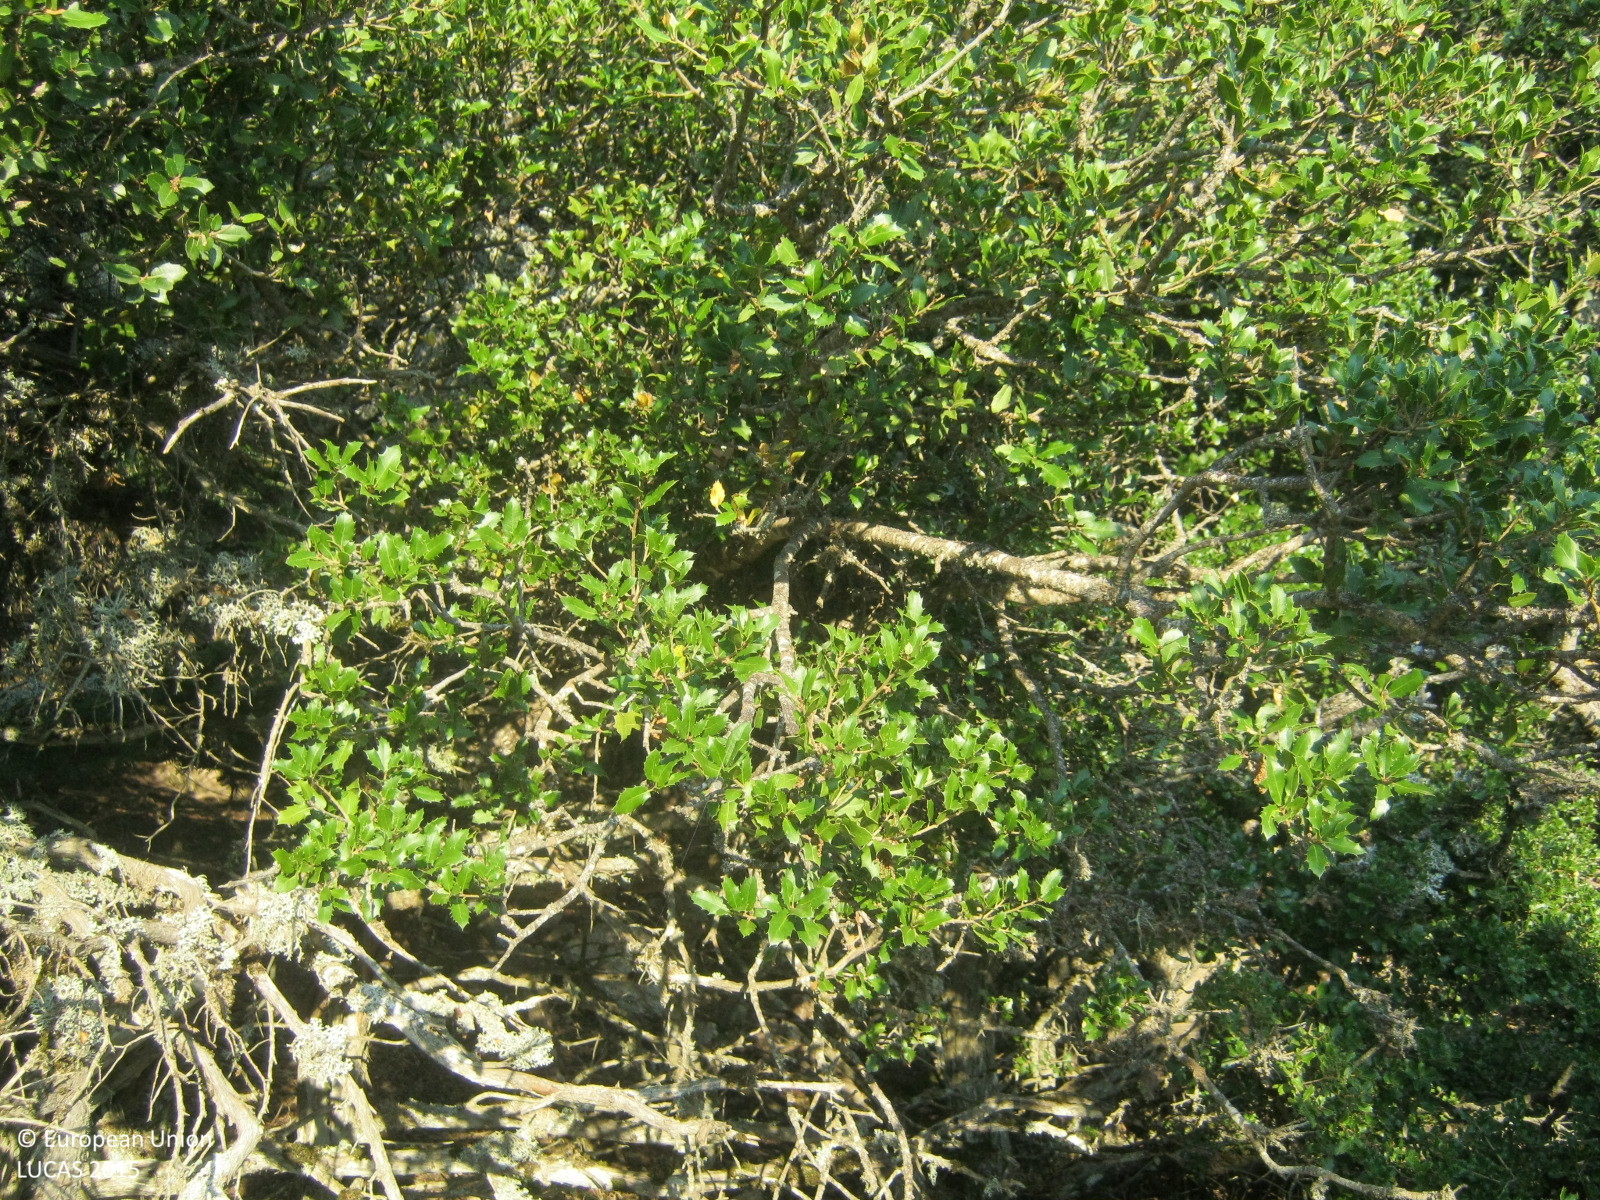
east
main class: Woodland
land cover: Spruce dominated mixed woodland
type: coniferous forest of the mediterranean region
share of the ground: 50 - 75 %
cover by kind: coniferous forest trees 45 %, broadleaved forest trees 25 %, shrubs 10 %, herbaceous plants 10 %, unconsolidated bare surface 10 %
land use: Forestry
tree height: > 5 m
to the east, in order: Spruce dominated mixed woodland; Shrubland without tree cover; Rock outcrops; Shrubland without tree cover; Grassland with sparse tree/shrub cover; Spruce dominated mixed woodland; Grassland with sparse tree/shrub cover
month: September
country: GR
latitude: 38.0431
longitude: 22.1713
